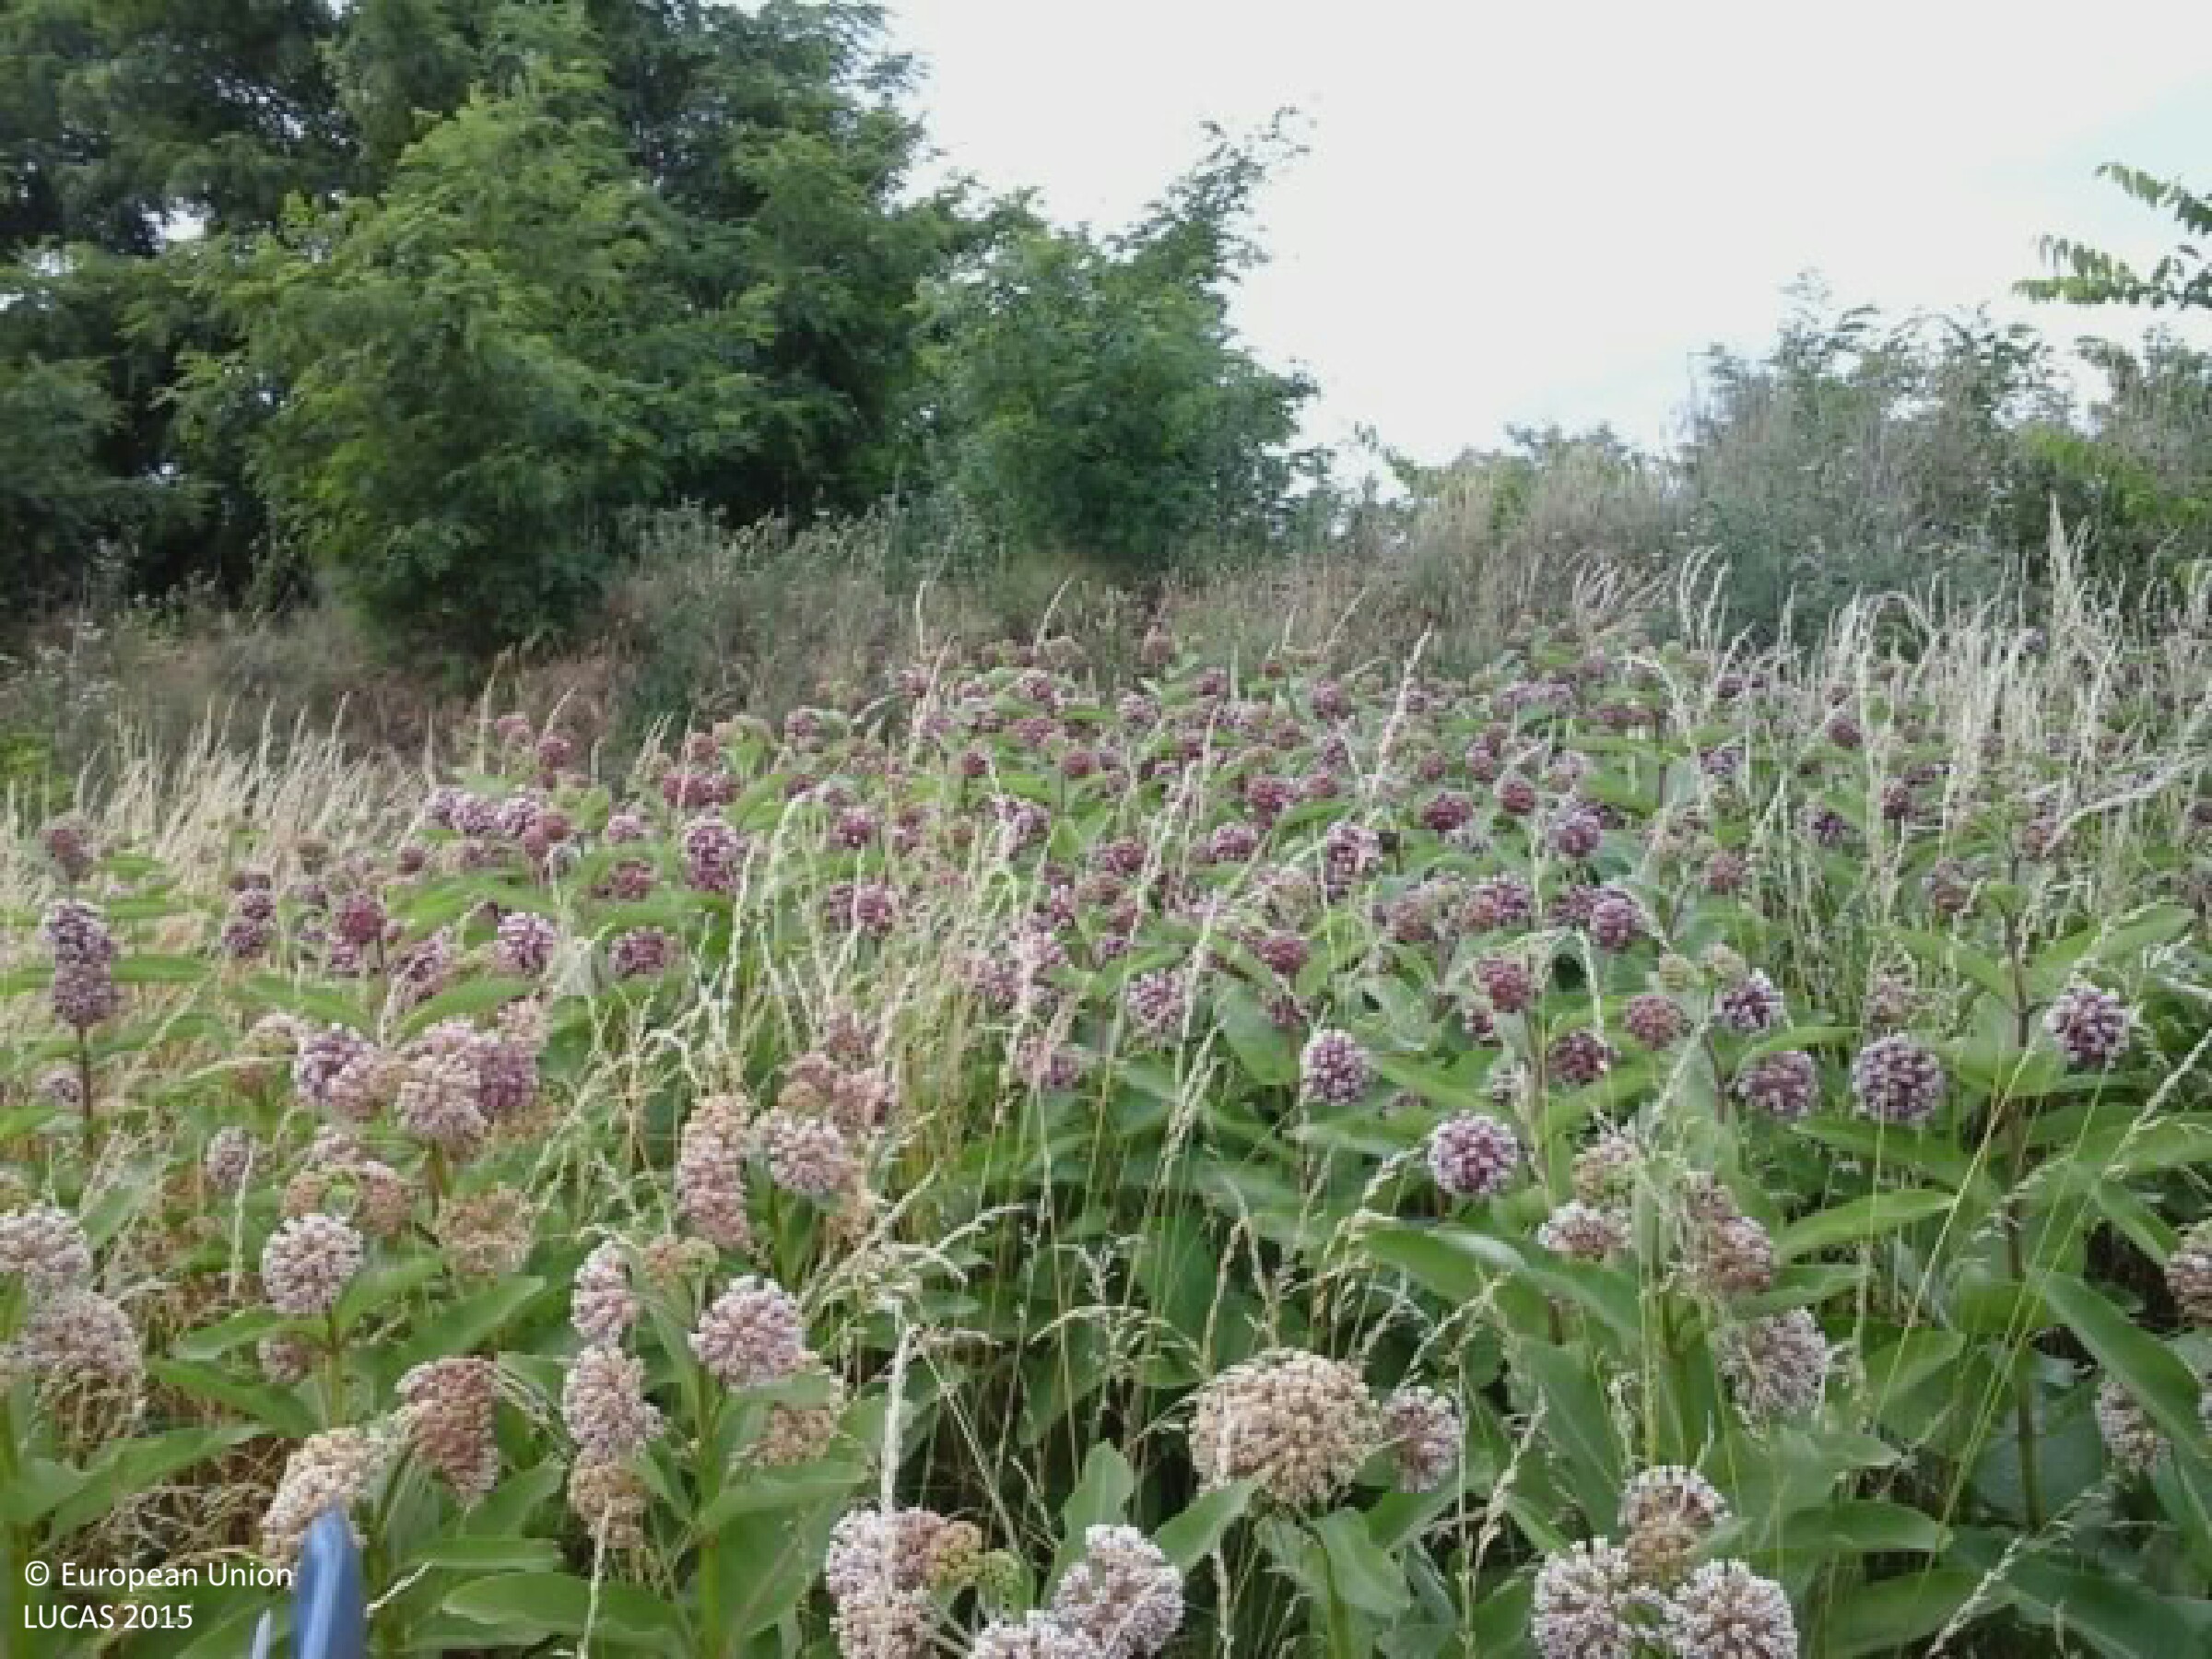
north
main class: Grassland
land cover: Grassland with sparse tree/shrub cover
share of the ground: > 75 %
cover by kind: herbaceous plants 85 %, shrubs 10 %, broadleaved forest trees 5 %
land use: Semi-natural and natural areas not in use
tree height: < 5 m
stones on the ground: 10 - 25 %
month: June
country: HU
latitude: 47.5639
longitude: 19.2303
